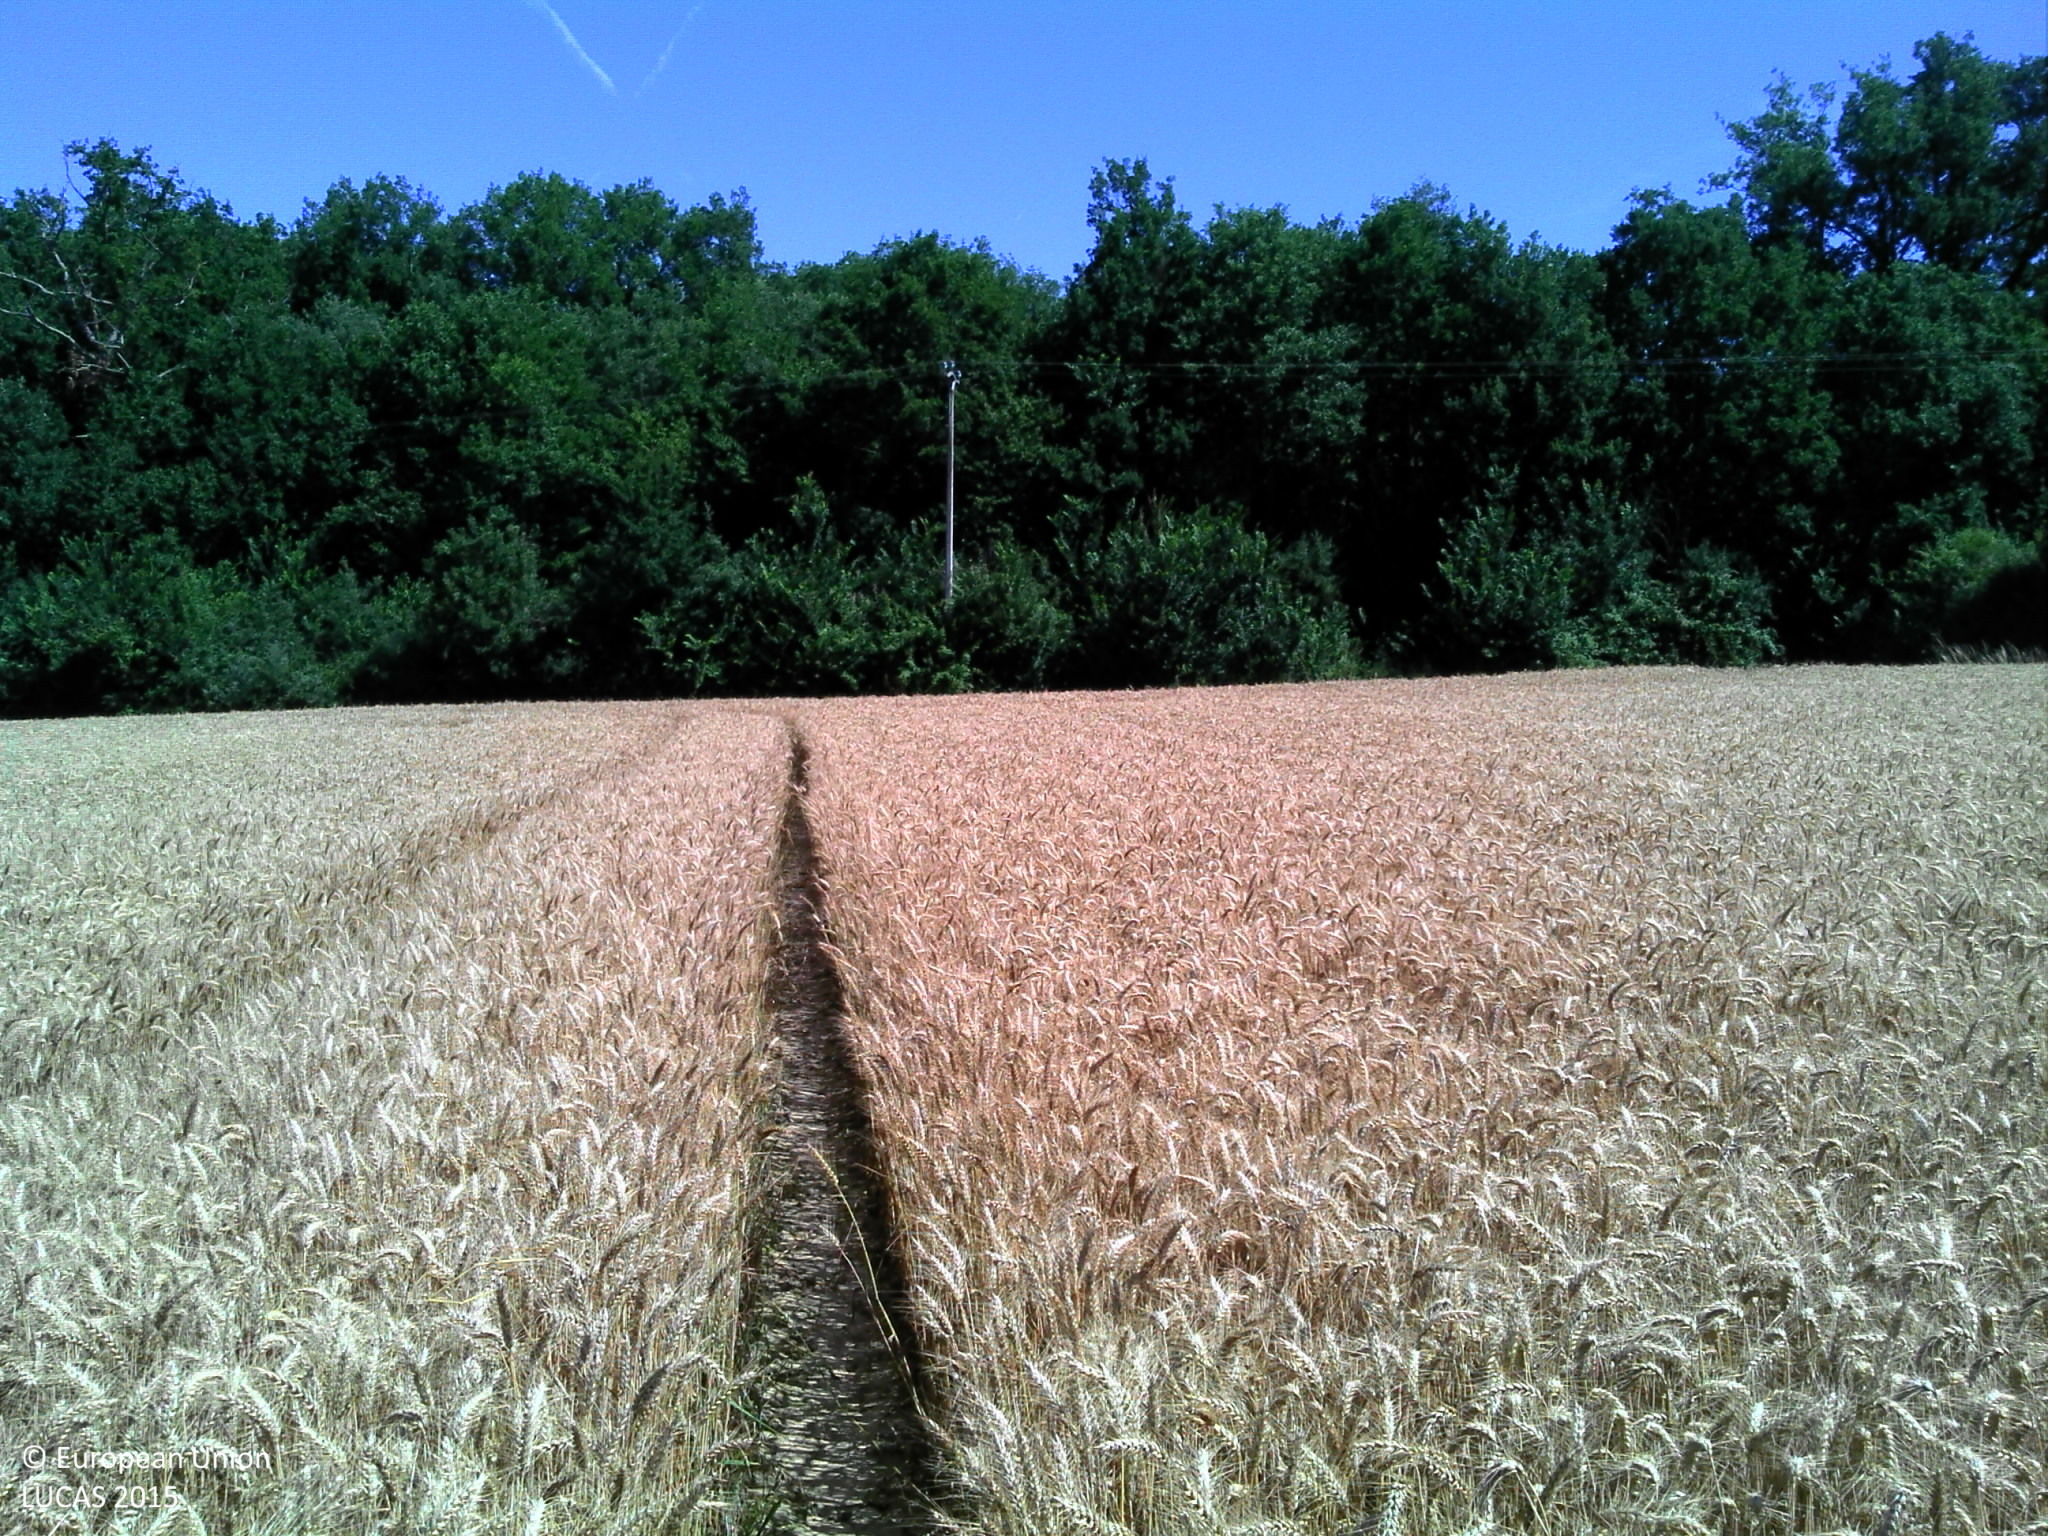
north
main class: Cropland
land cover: Common wheat
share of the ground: > 75 %
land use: Agriculture (excluding fallow land and kitchen gardens)
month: June
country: FR
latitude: 43.7788
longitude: 1.0163
